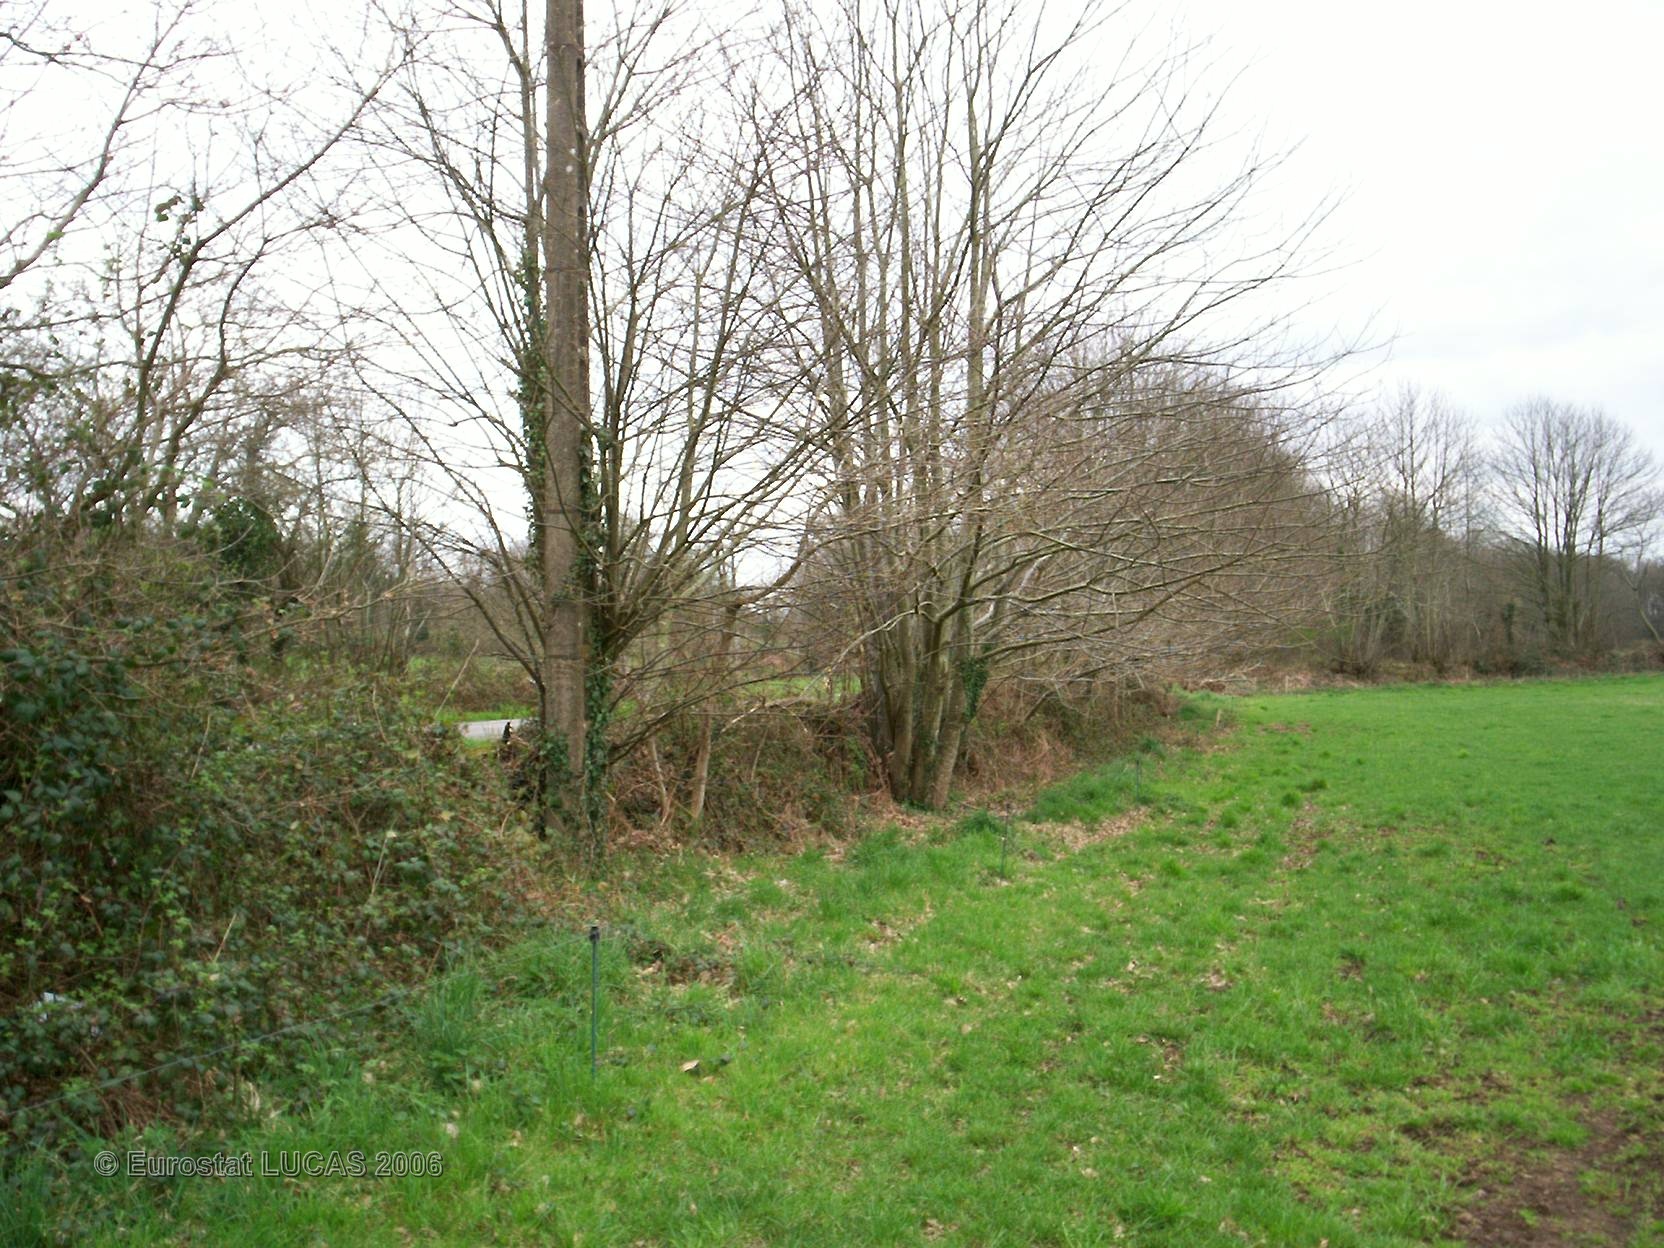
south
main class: Grassland
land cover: Grassland without tree/shrub cover
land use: Agriculture (excluding fallow land and kitchen gardens)
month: April
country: FR
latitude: 47.9530
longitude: -3.5071
